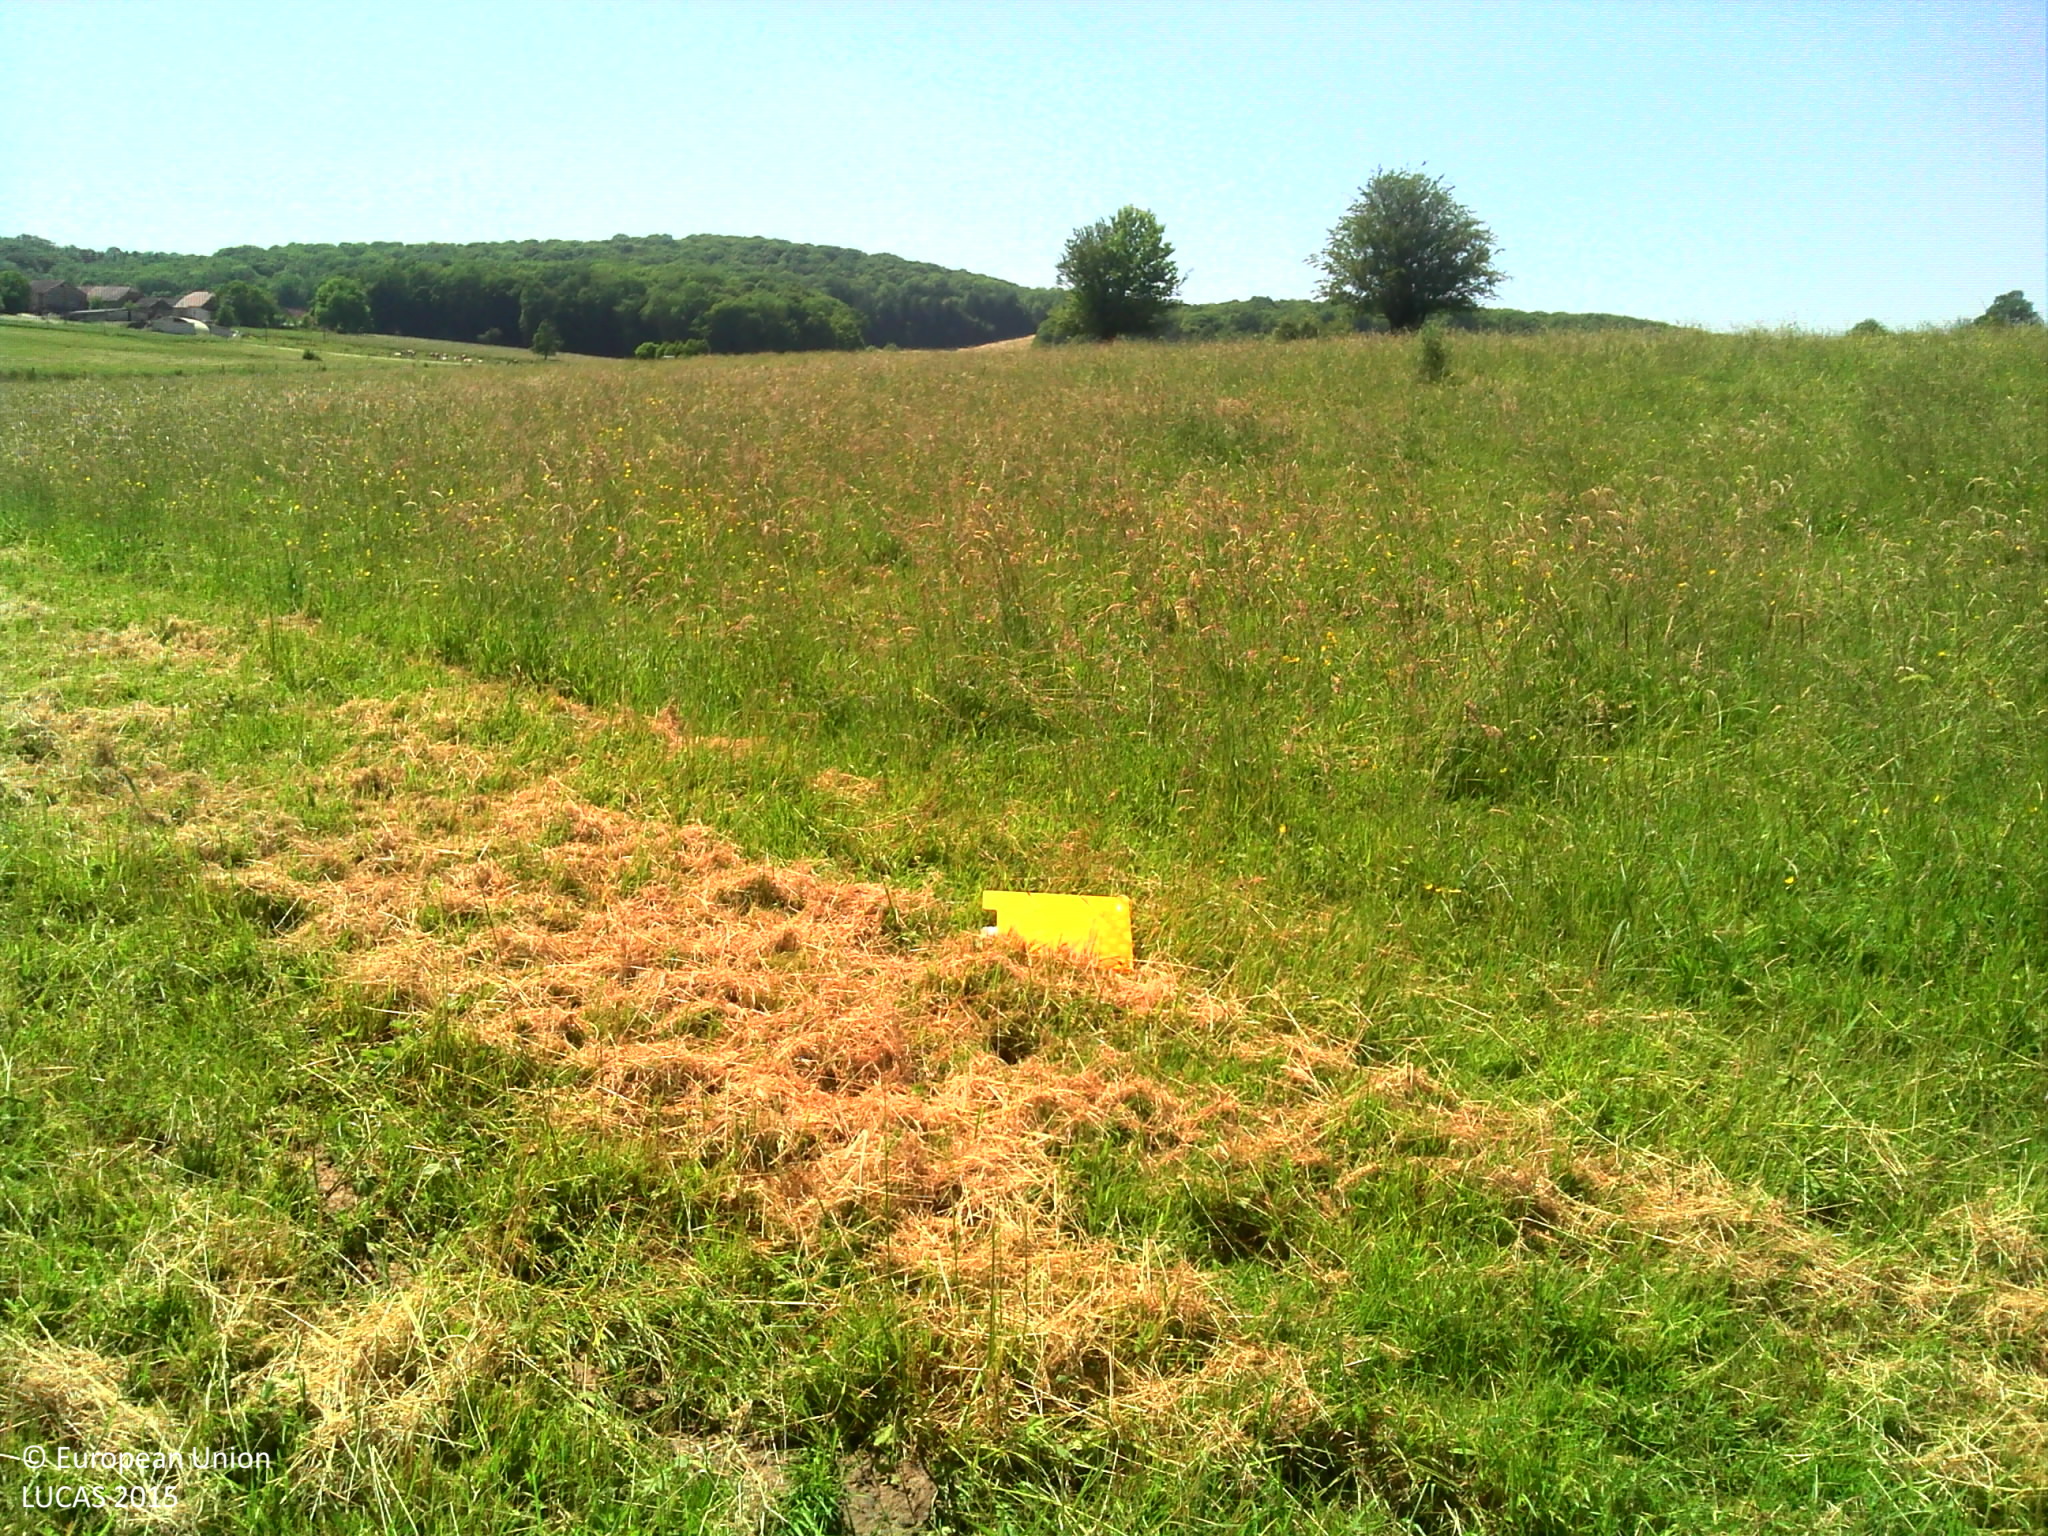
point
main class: Grassland
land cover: Grassland without tree/shrub cover
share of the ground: > 75 %
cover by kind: herbaceous plants 100 %
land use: Agriculture (excluding fallow land and kitchen gardens)
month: June
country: FR
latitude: 47.6907
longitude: 6.2307
